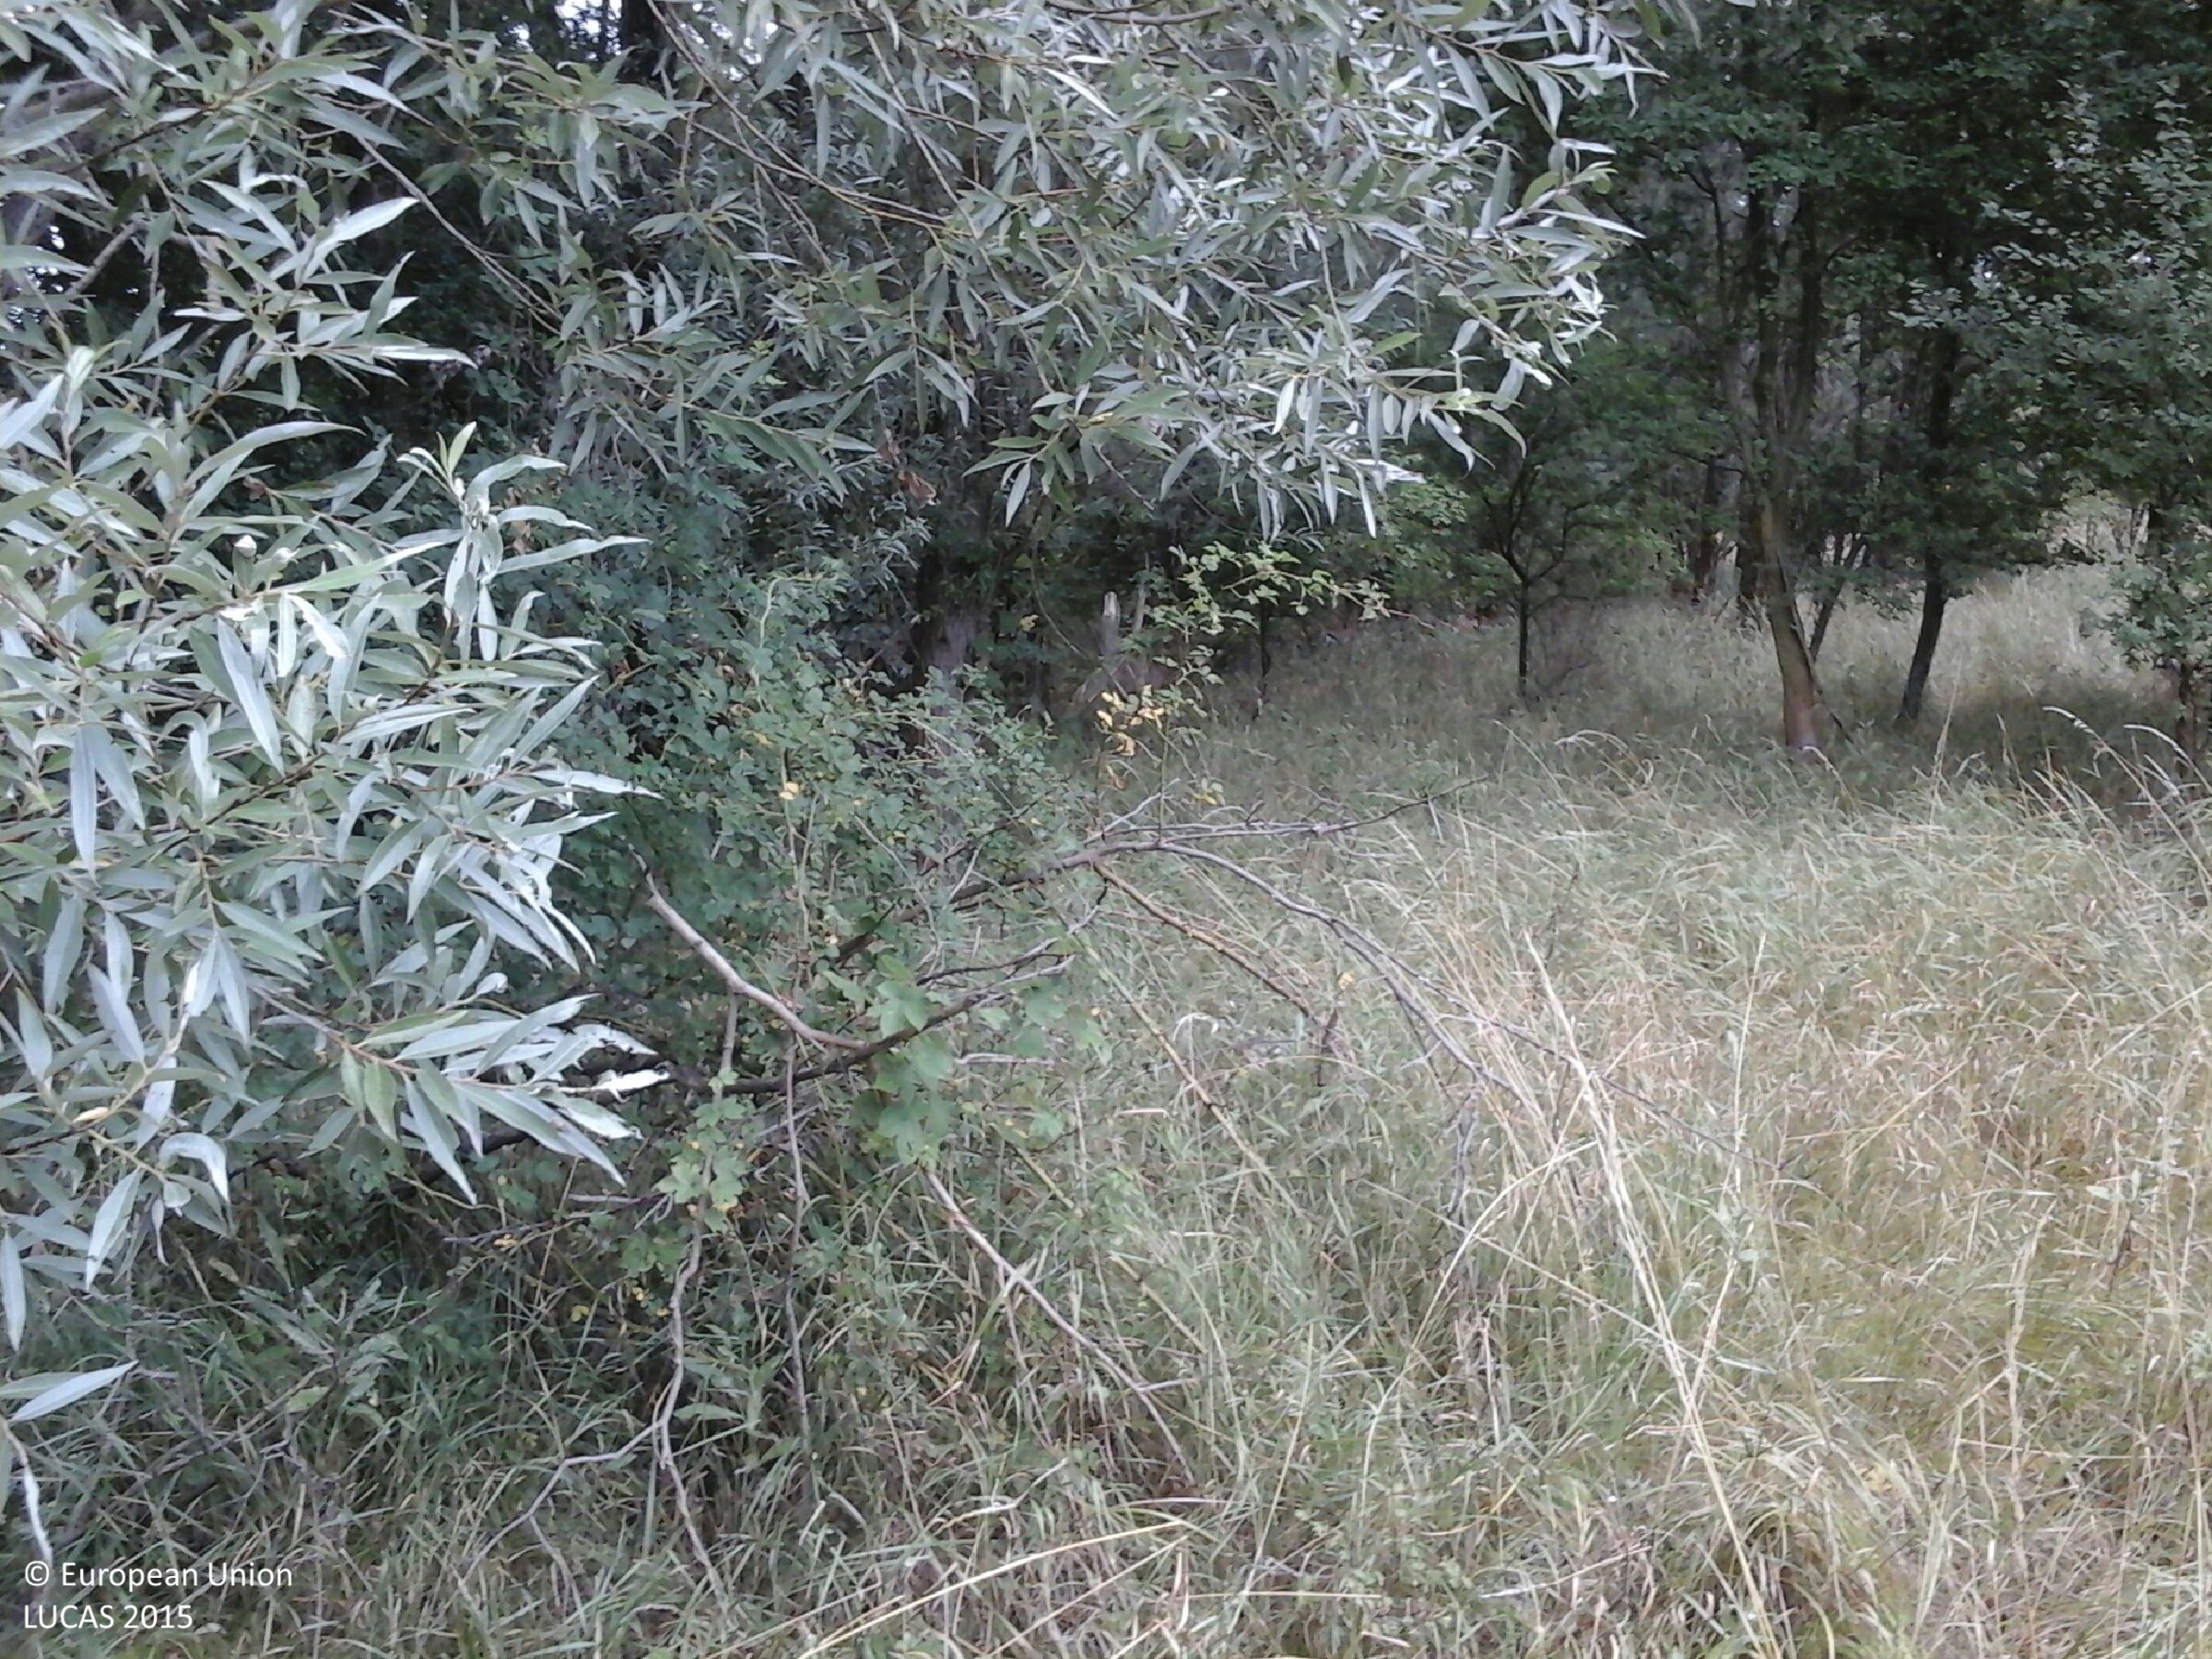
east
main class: Woodland
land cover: Broadleaved woodland
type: mesophytic deciduous forest
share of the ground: 50 - 75 %
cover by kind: broadleaved forest trees 70 %, herbaceous plants 30 %
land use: Forestry
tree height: > 5 m
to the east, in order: Broadleaved woodland; Shrubland with sparse tree cover; Inland marshes; Shrubland with sparse tree cover
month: July
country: HU
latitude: 47.5277
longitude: 20.6183
